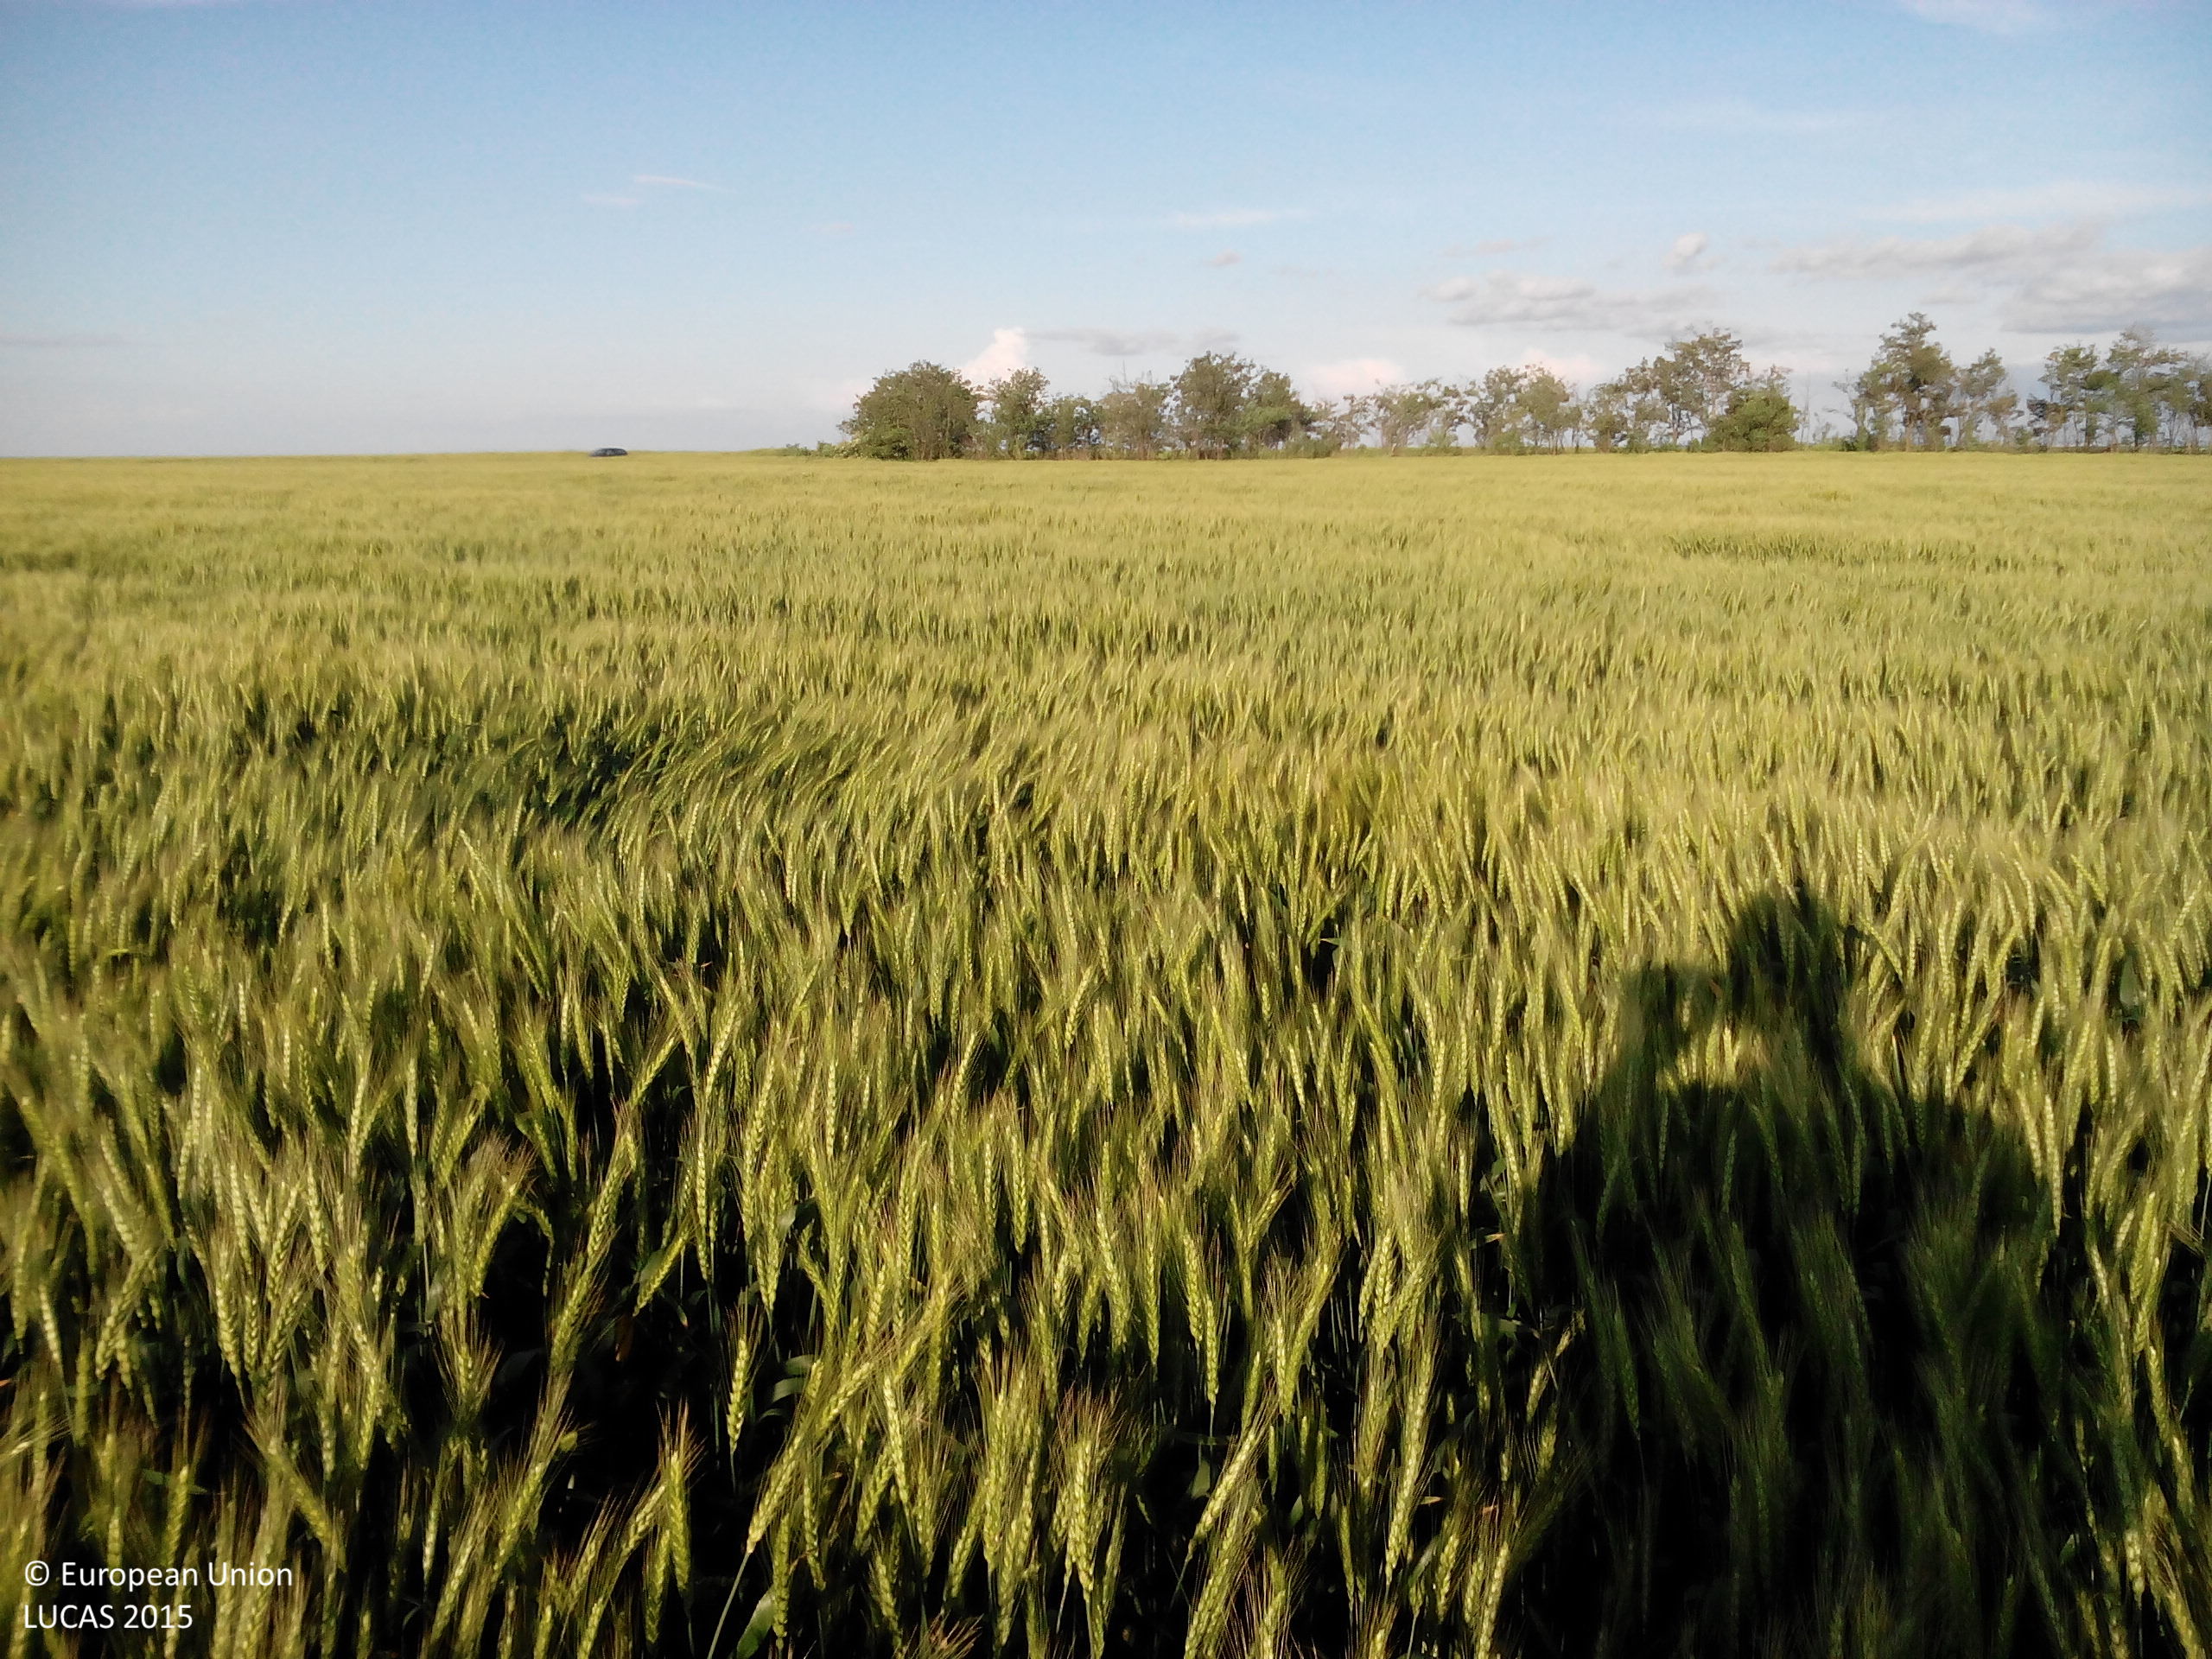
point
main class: Cropland
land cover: Common wheat
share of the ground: > 75 %
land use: Agriculture (excluding fallow land and kitchen gardens)
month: May
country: BG
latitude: 43.5994
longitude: 24.1159
